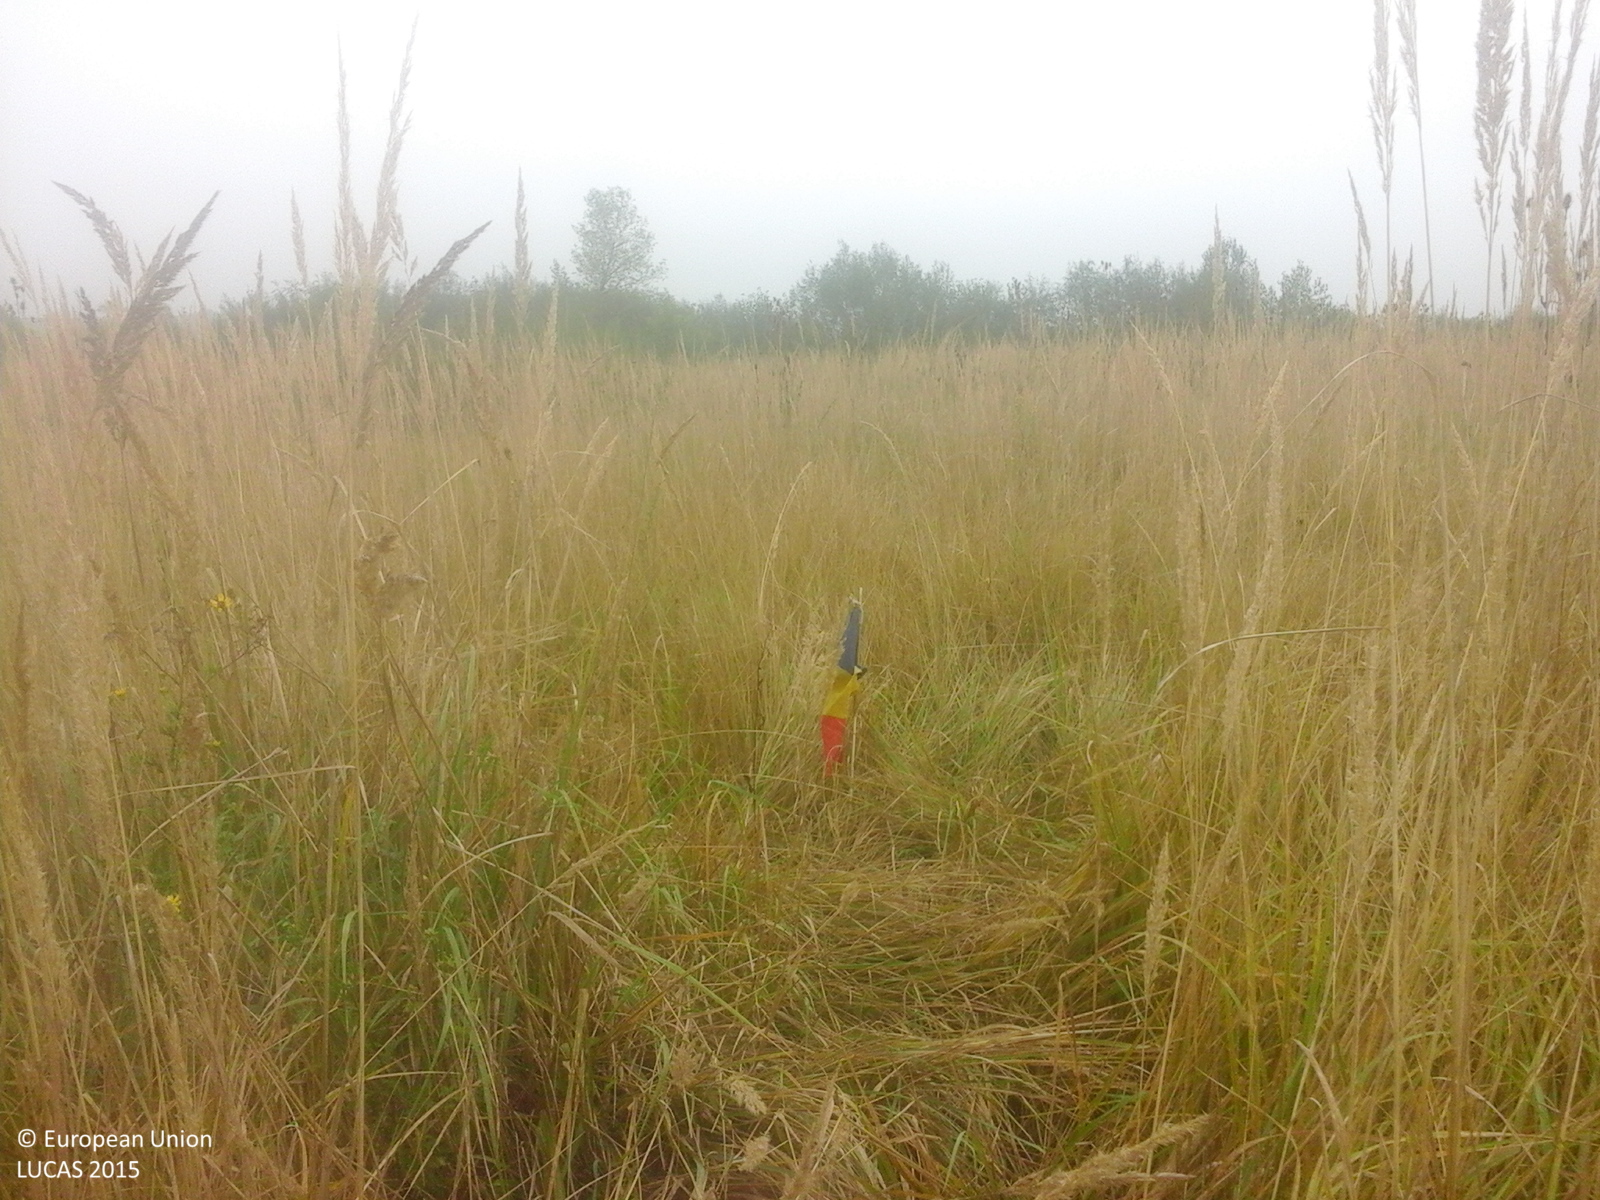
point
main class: Grassland
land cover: Spontaneously vegetated surfaces
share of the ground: > 75 %
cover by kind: herbaceous plants 100 %
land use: Fallow land
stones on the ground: < 10 %
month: September
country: RO
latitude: 45.8308
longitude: 22.0519
